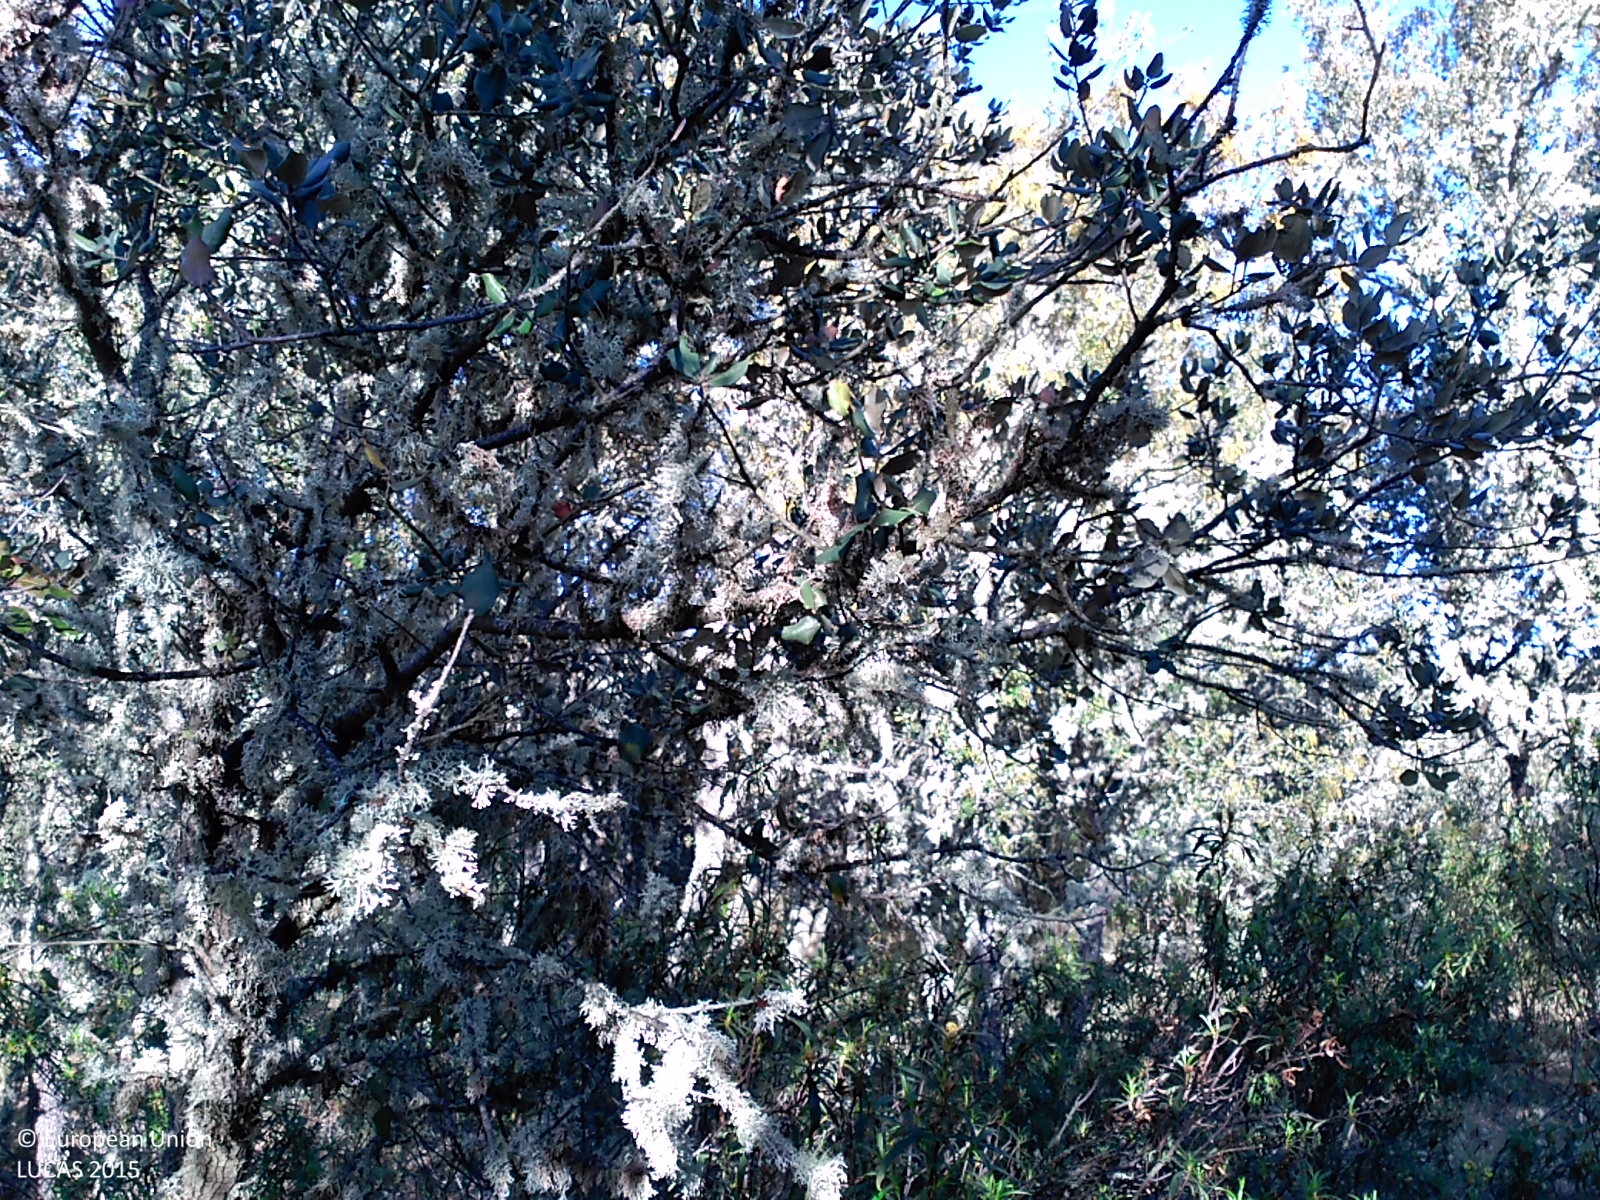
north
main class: Woodland
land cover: Broadleaved woodland
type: broadleaved evergreen forest
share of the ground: > 75 %
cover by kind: broadleaved forest trees 90 %, shrubs 10 %
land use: Forestry
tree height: > 5 m
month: May
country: ES
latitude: 42.0228
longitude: -5.9552
